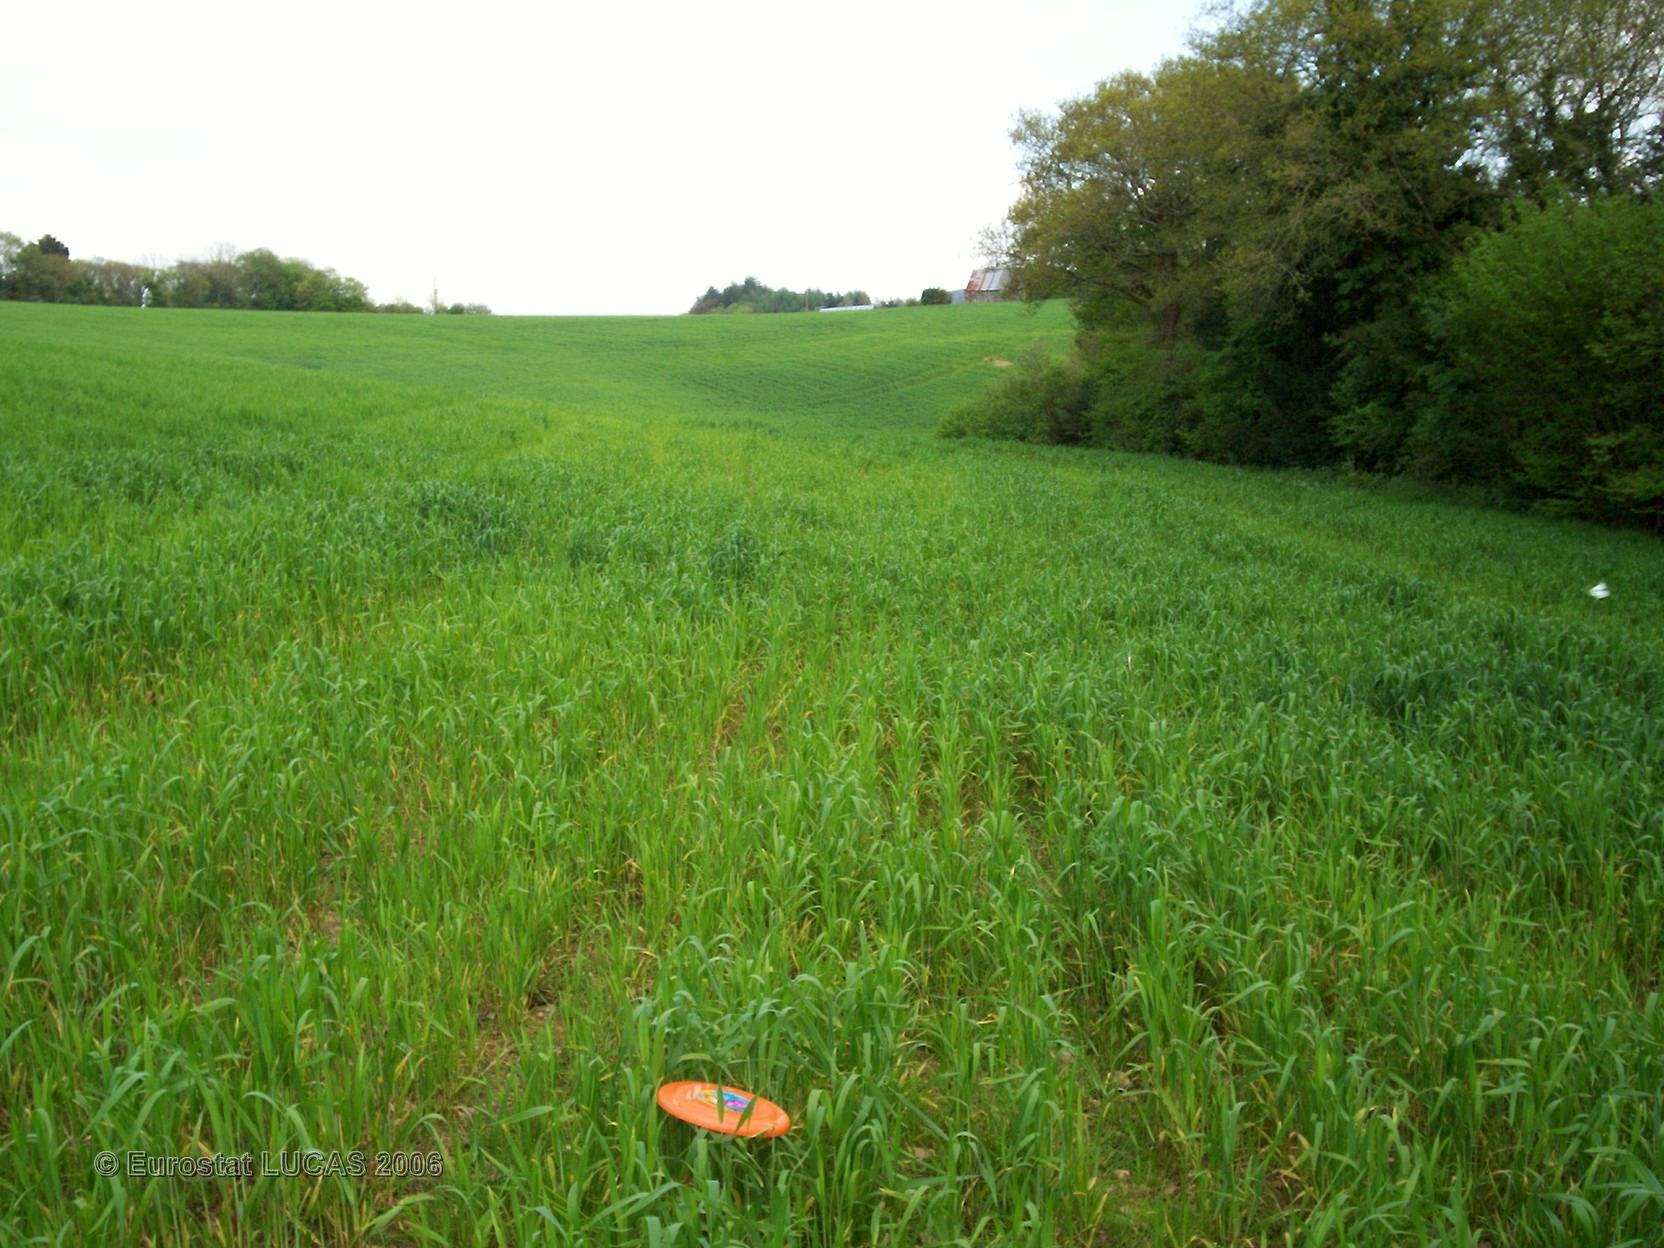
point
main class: Cropland
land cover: Barley
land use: Agriculture (excluding fallow land and kitchen gardens)
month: May
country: FR
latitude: 48.3909
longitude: -3.6537
